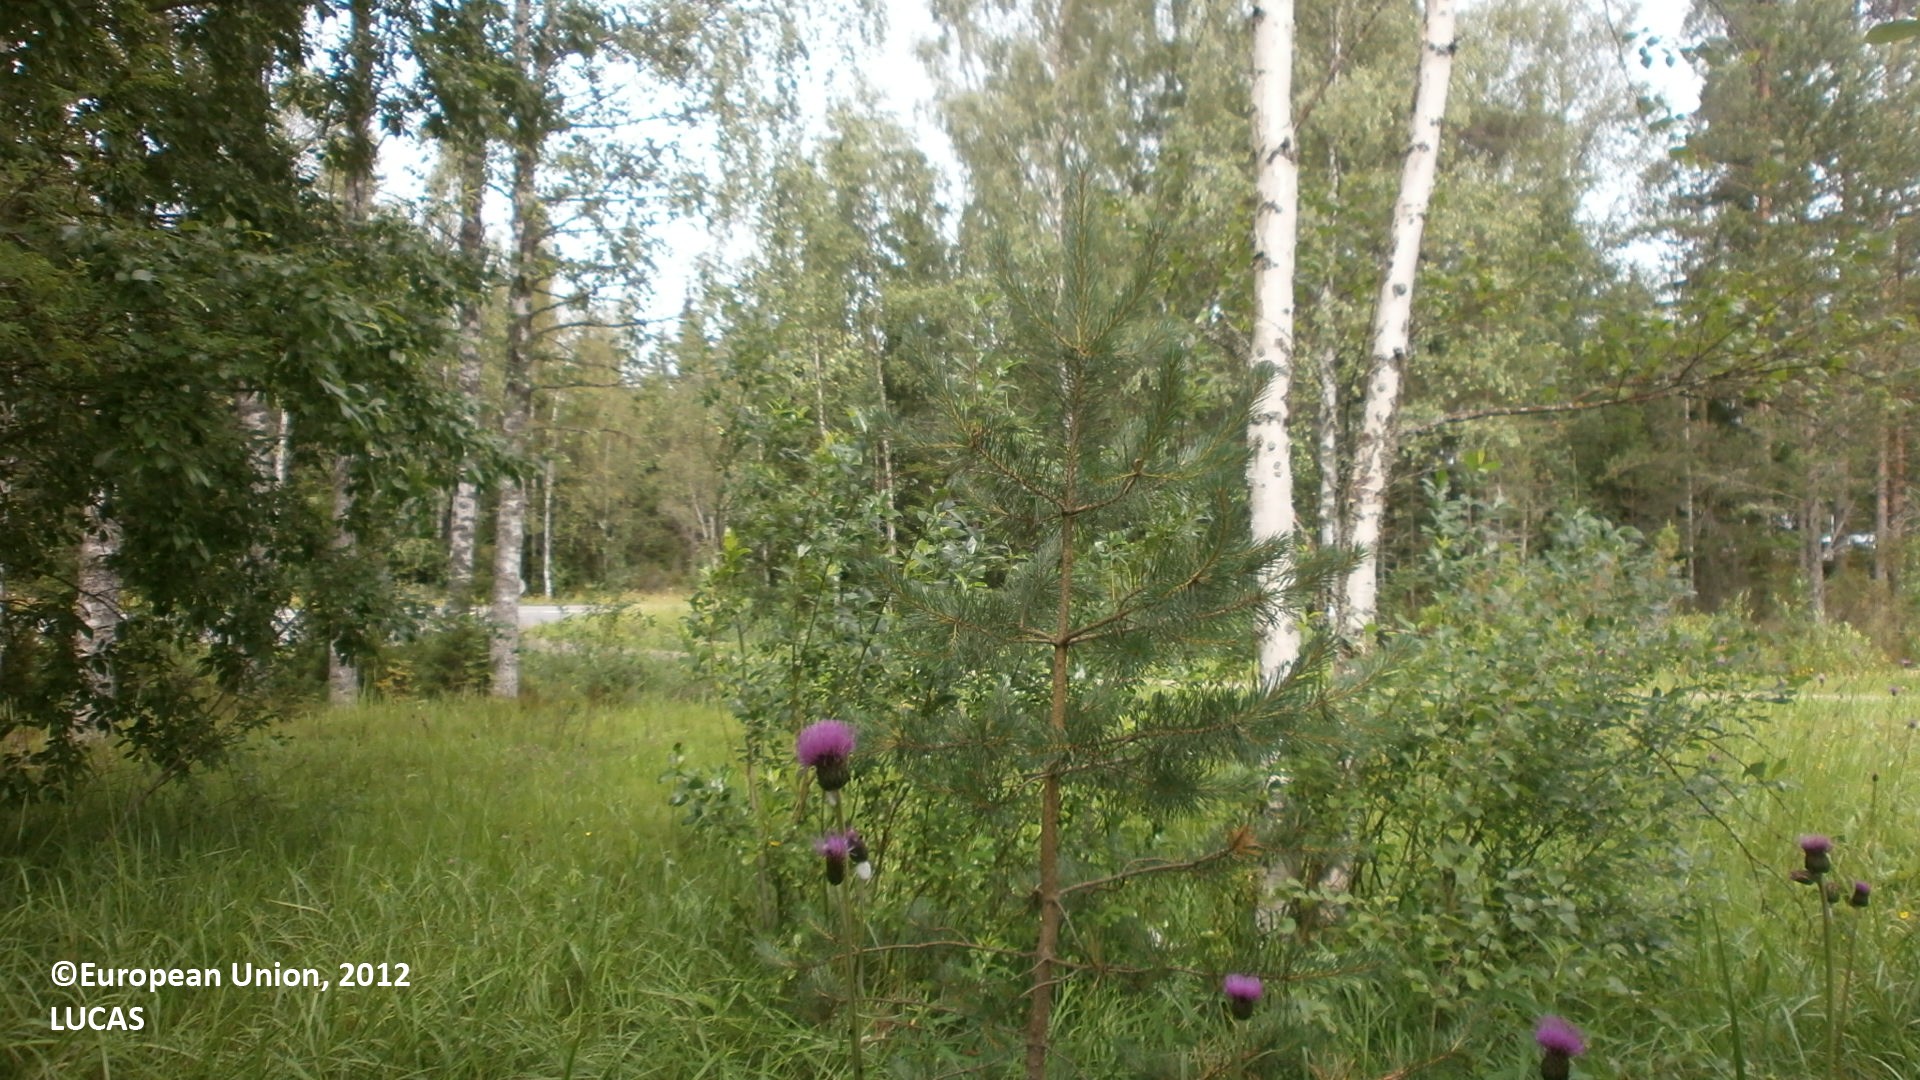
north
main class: Woodland
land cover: Broadleaved woodland
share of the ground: 10 - 25 %
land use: Residential
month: July
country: FI
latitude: 64.2555
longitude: 24.3690
